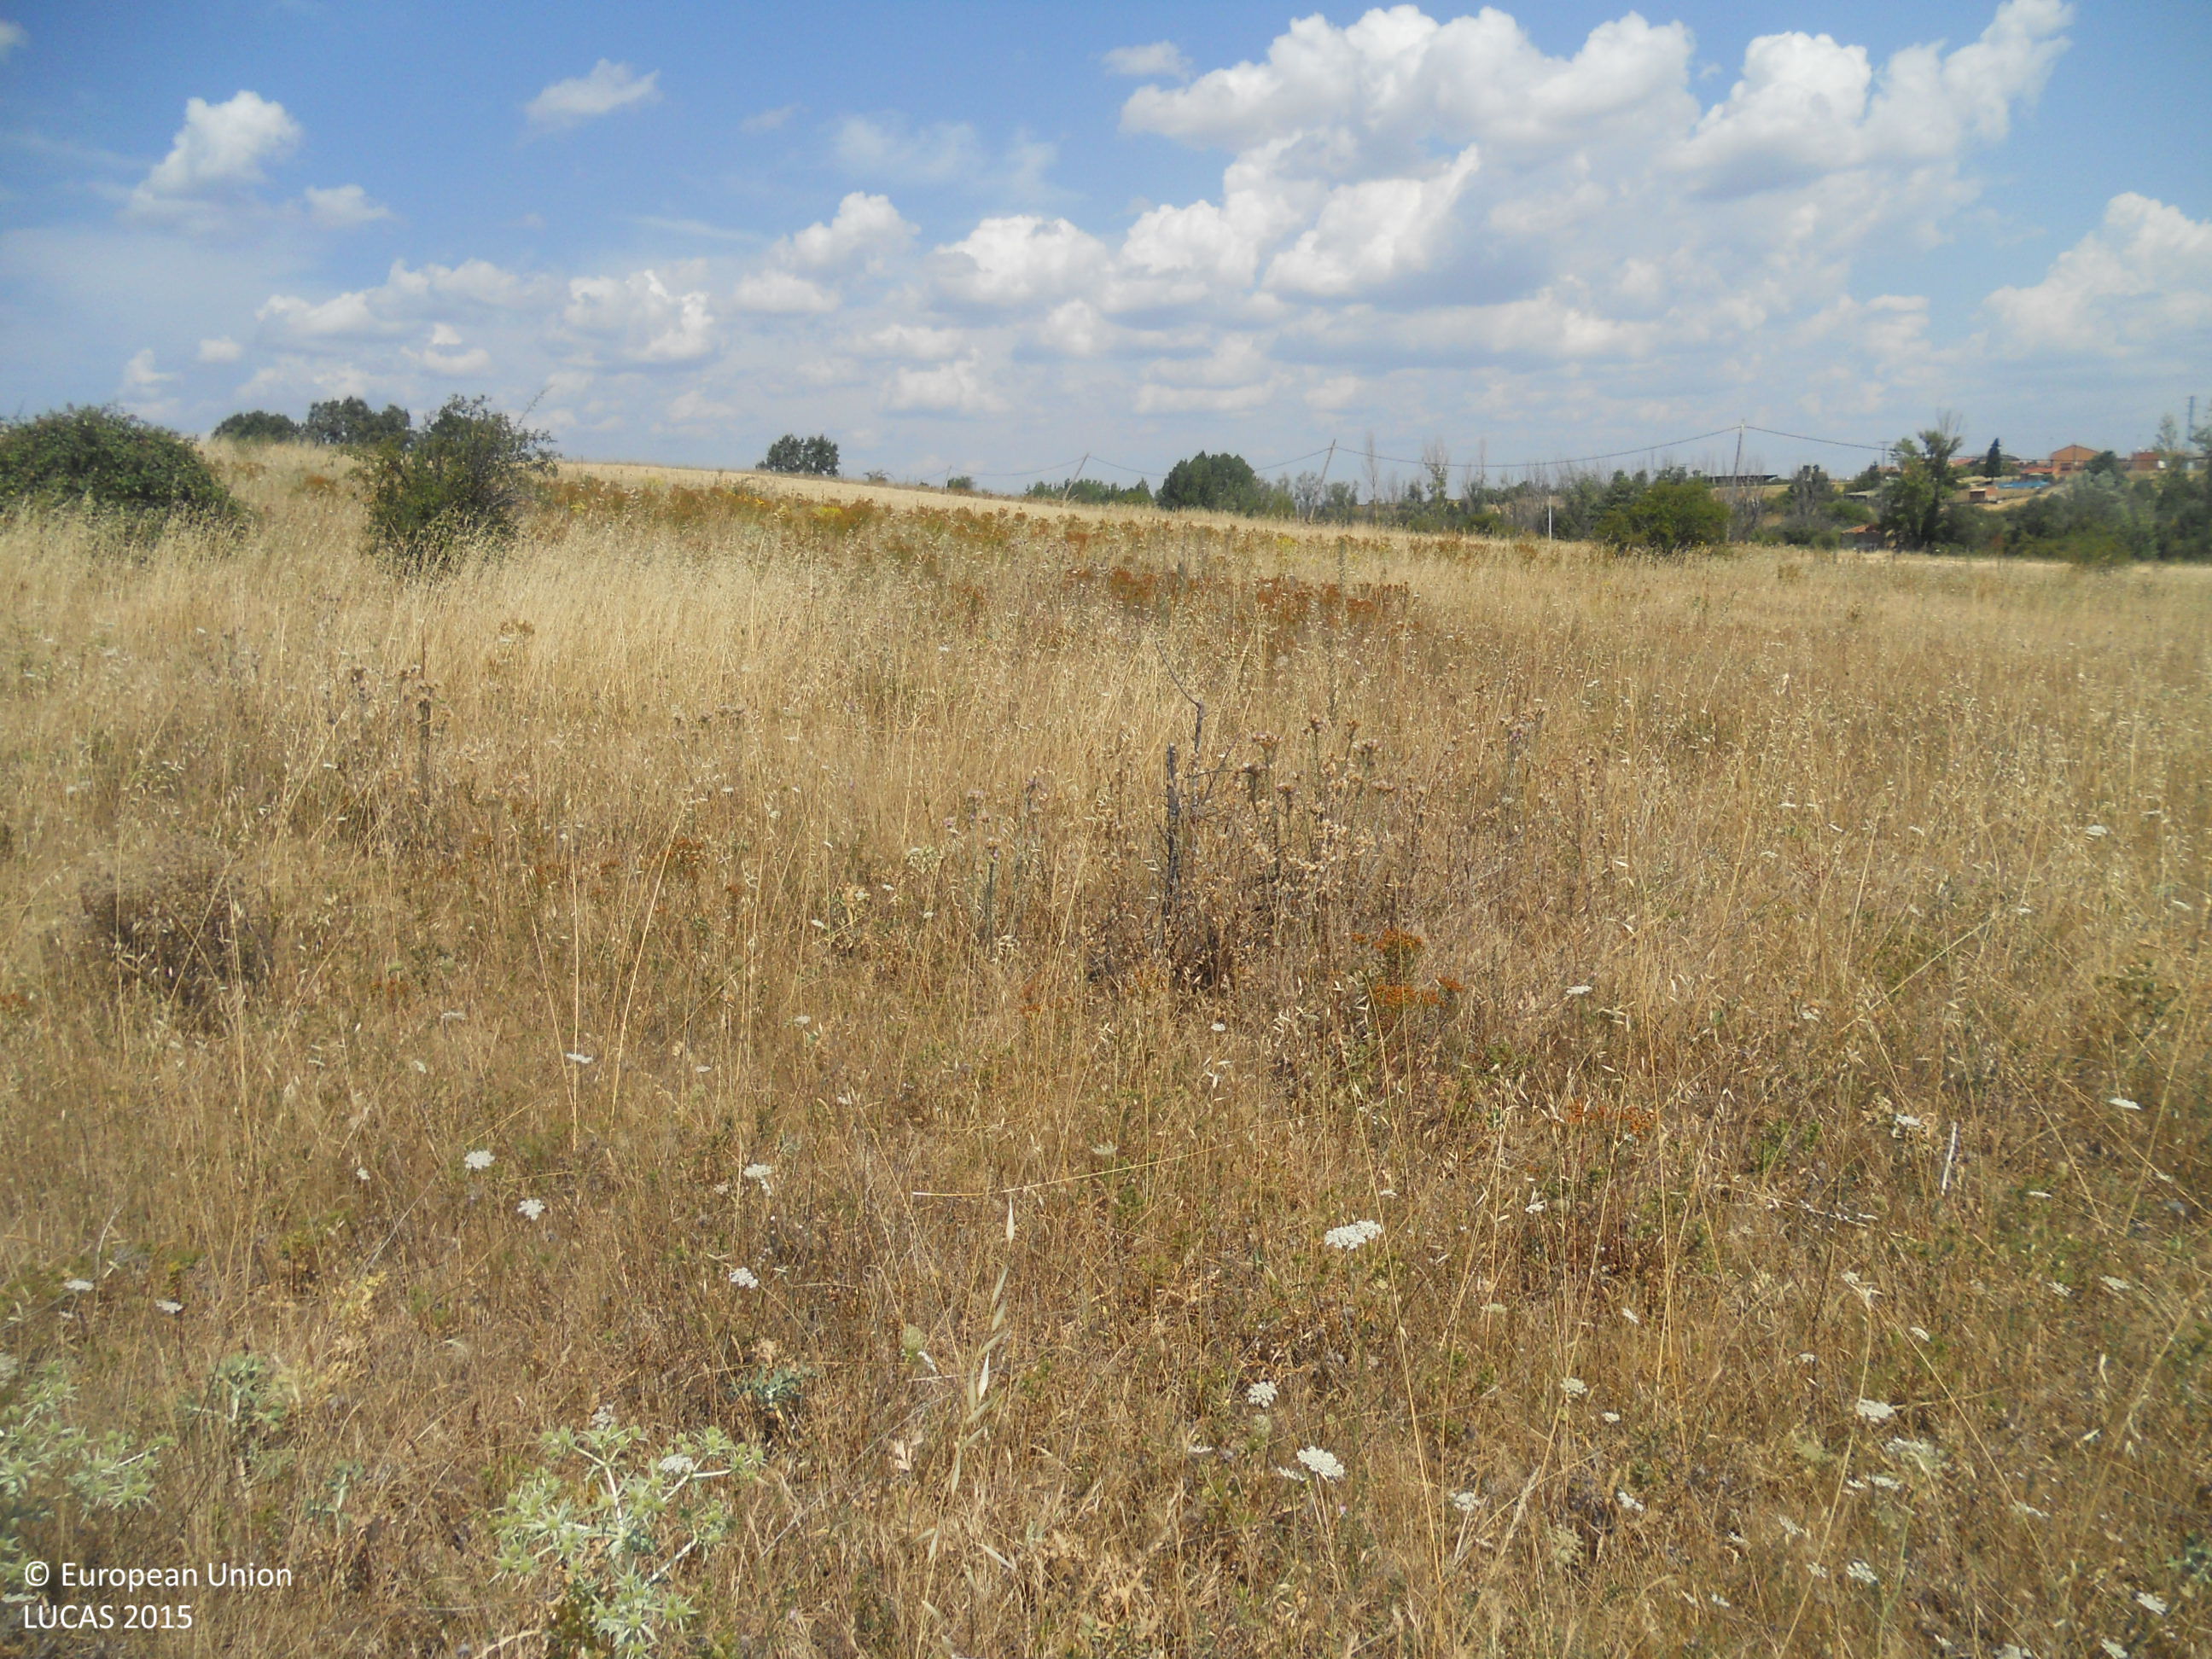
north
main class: Grassland
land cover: Grassland without tree/shrub cover
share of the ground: > 75 %
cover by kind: herbaceous plants 100 %
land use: Semi-natural and natural areas not in use
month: July
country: ES
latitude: 42.5738
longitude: -5.6064
